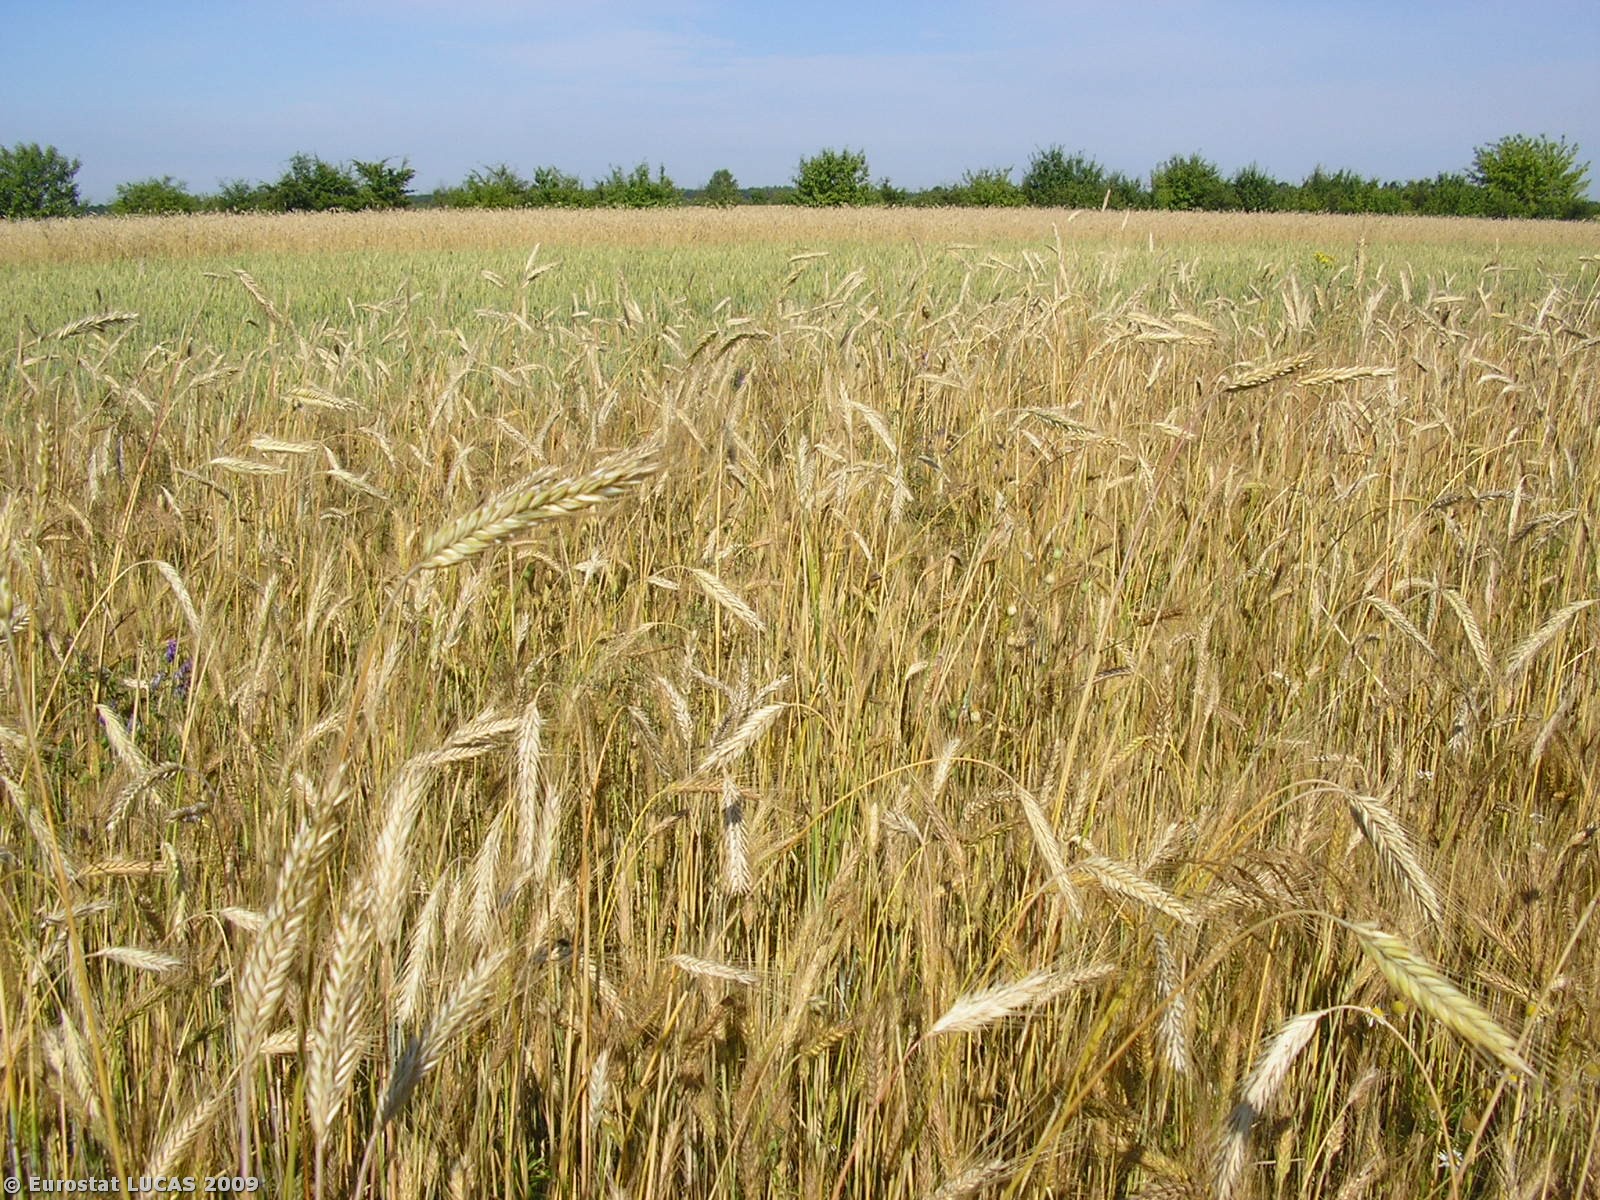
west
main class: Cropland
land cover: Triticale
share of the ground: > 75 %
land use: Agriculture (excluding fallow land and kitchen gardens)
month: July
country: PL
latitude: 52.4841
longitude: 20.7763
